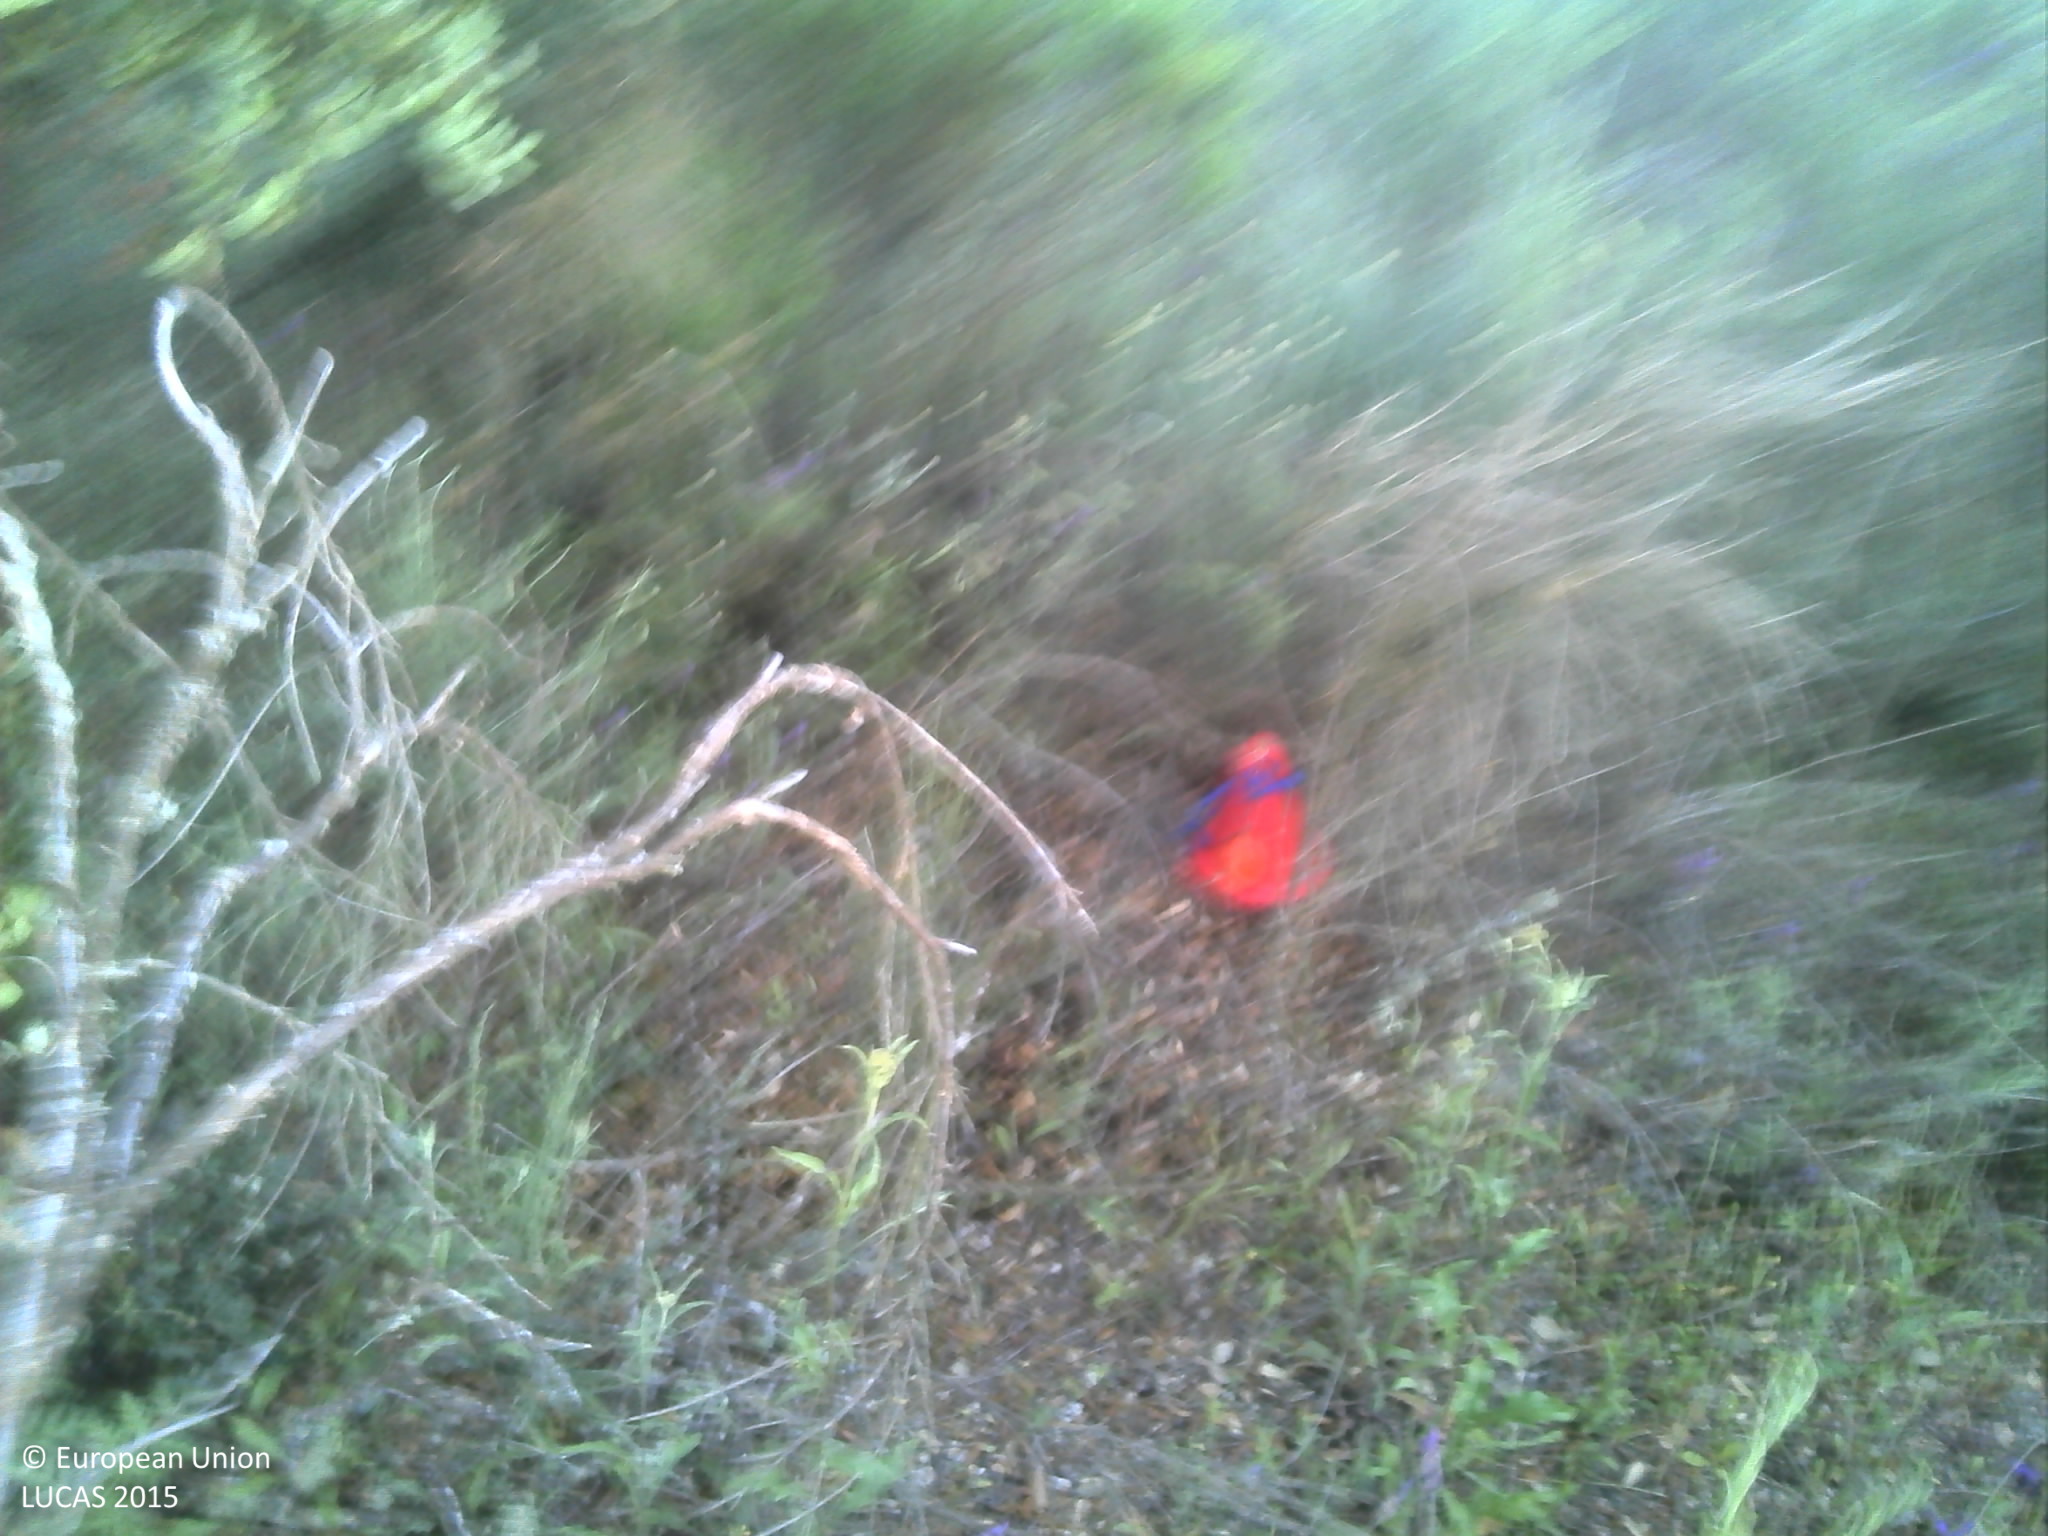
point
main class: Shrubland
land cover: Shrubland with sparse tree cover
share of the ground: > 75 %
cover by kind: shrubs 95 %, broadleaved forest trees 5 %
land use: Abandoned areas
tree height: > 5 m
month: May
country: PT
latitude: 40.6648
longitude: -7.3444
